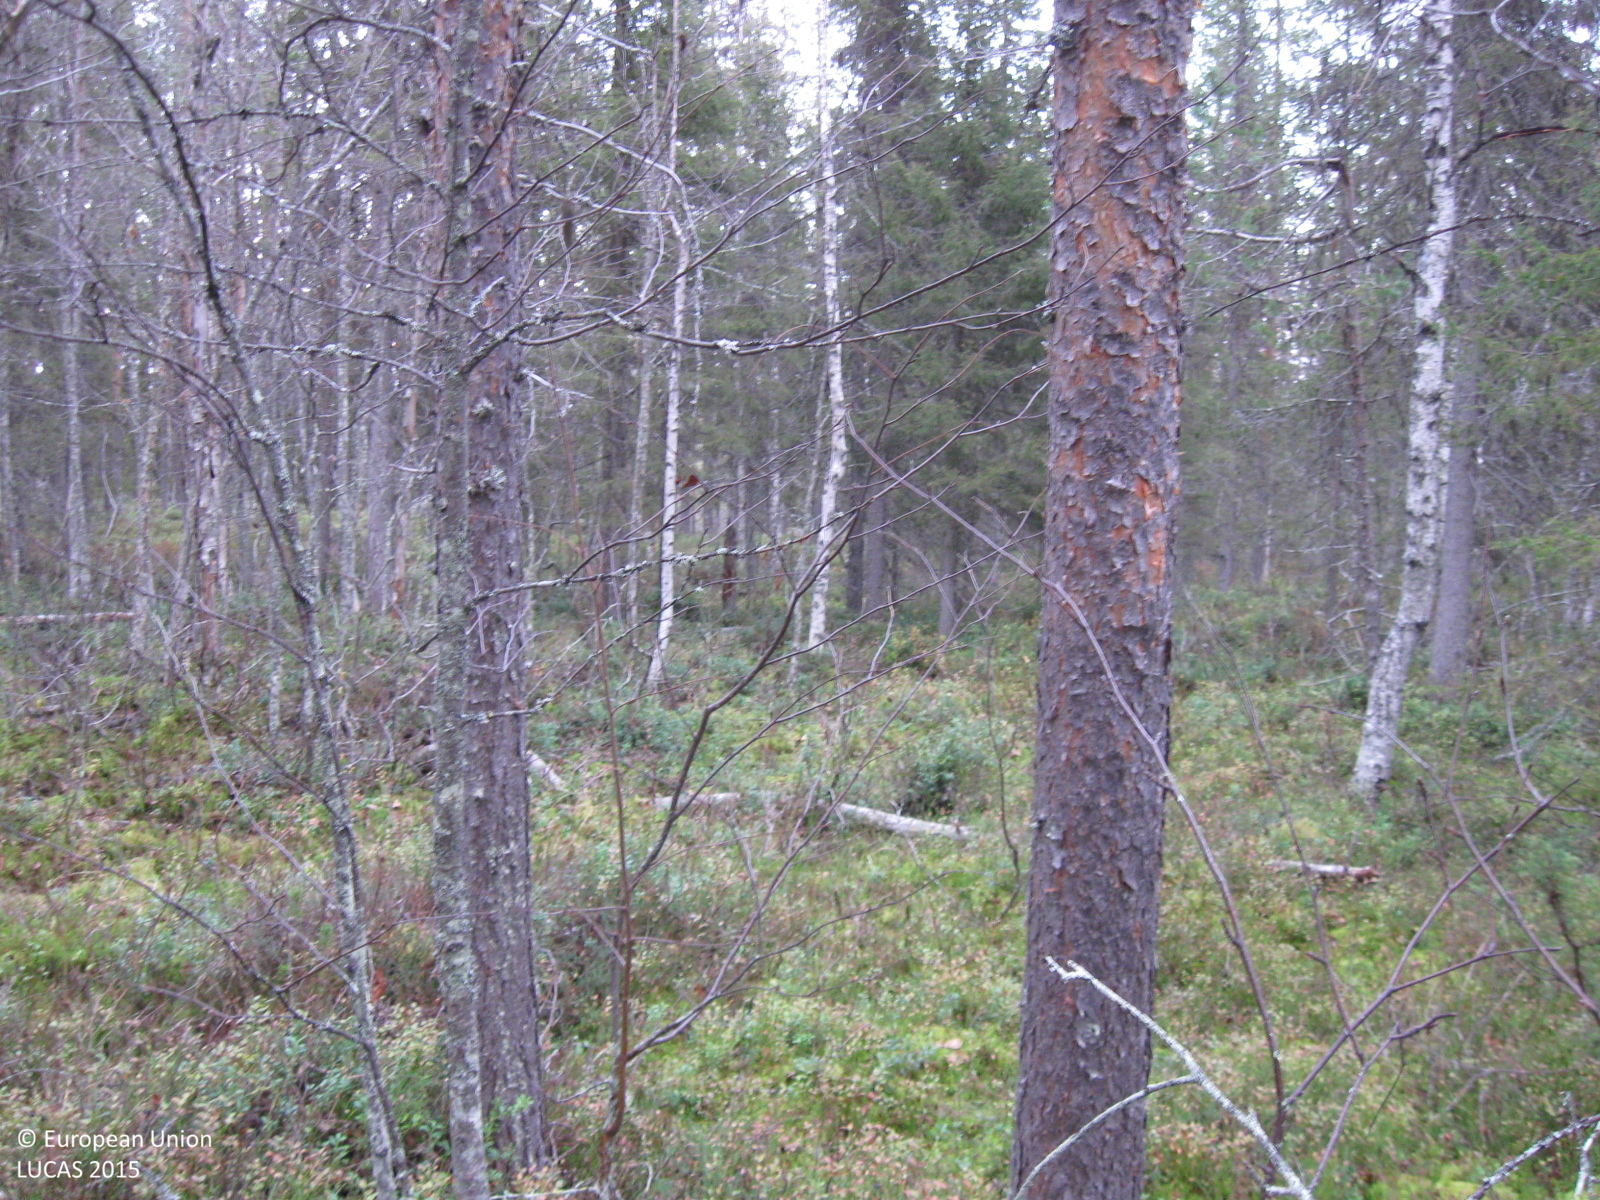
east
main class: Woodland
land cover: Pine dominated mixed woodland
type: boreal forest
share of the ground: > 75 %
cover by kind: coniferous forest trees 60 %, broadleaved forest trees 20 %, shrubs 10 %, herbaceous plants 5 %, lichens and mosses 5 %
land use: Forestry
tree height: > 5 m
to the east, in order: Pine dominated mixed woodland; Pine dominated coniferous woodland; Spruce dominated mixed woodland; Pine dominated mixed woodland; Spruce dominated mixed woodland
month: October
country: SE
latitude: 66.1937
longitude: 22.0264
